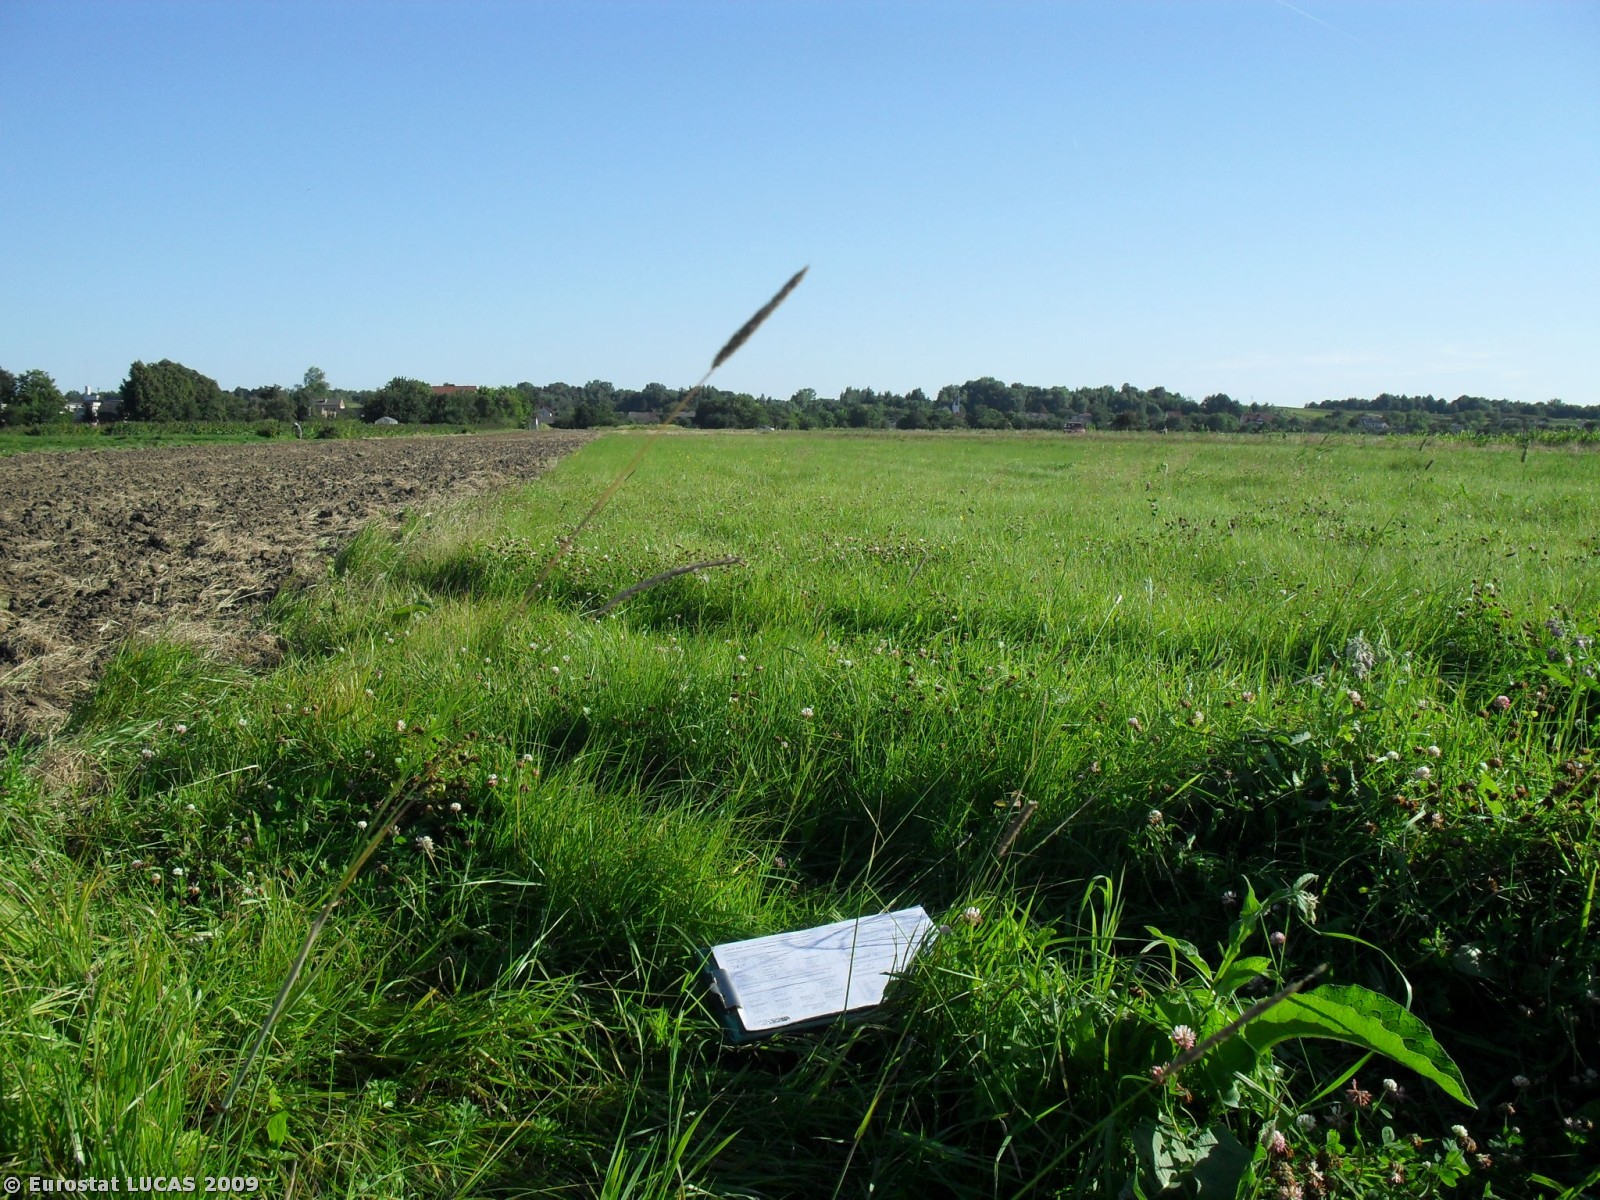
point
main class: Grassland
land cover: Grassland without tree/shrub cover
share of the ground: > 75 %
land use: Agriculture (excluding fallow land and kitchen gardens)
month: August
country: PL
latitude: 51.3991
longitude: 22.0323
